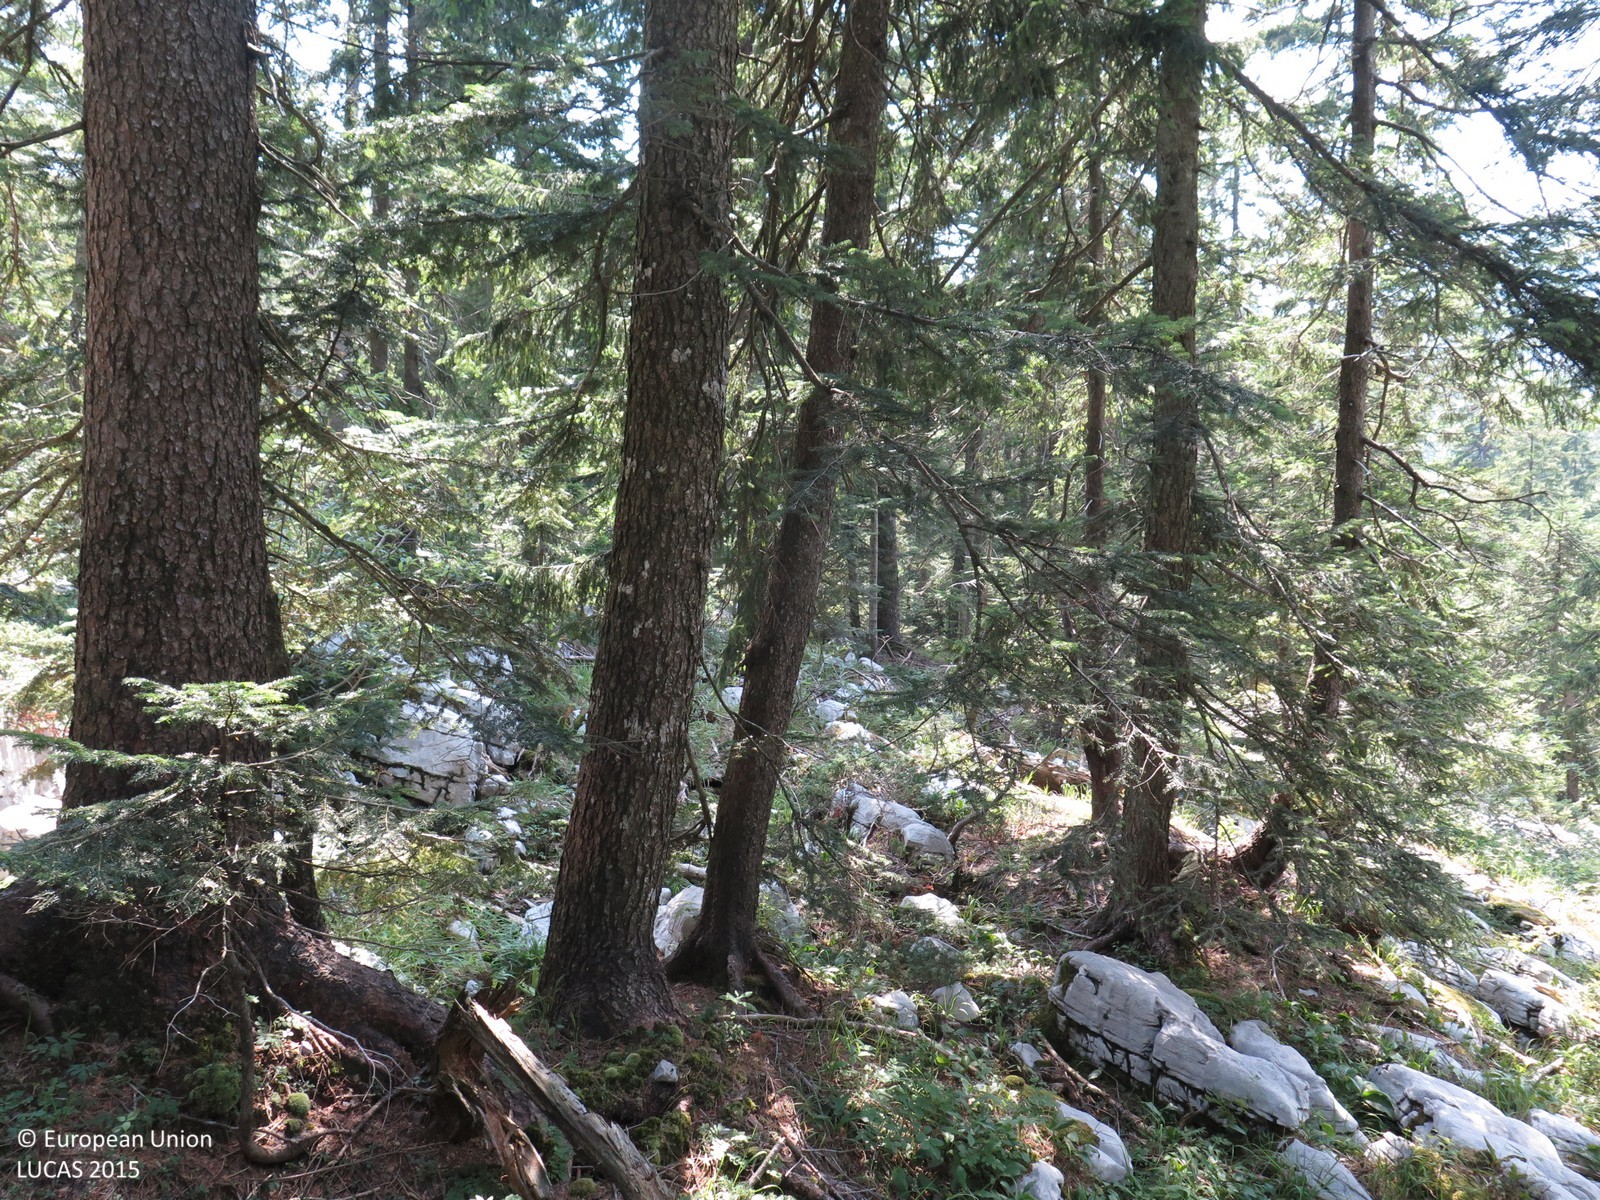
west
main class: Woodland
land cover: Other mixed woodland
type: coniferous forest of the mediterranean region
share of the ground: > 75 %
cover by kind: coniferous forest trees 70 %, broadleaved forest trees 25 %, unconsolidated bare surface 5 %
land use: Forestry
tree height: > 5 m
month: August
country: HR
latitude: 45.4960
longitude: 14.5638
